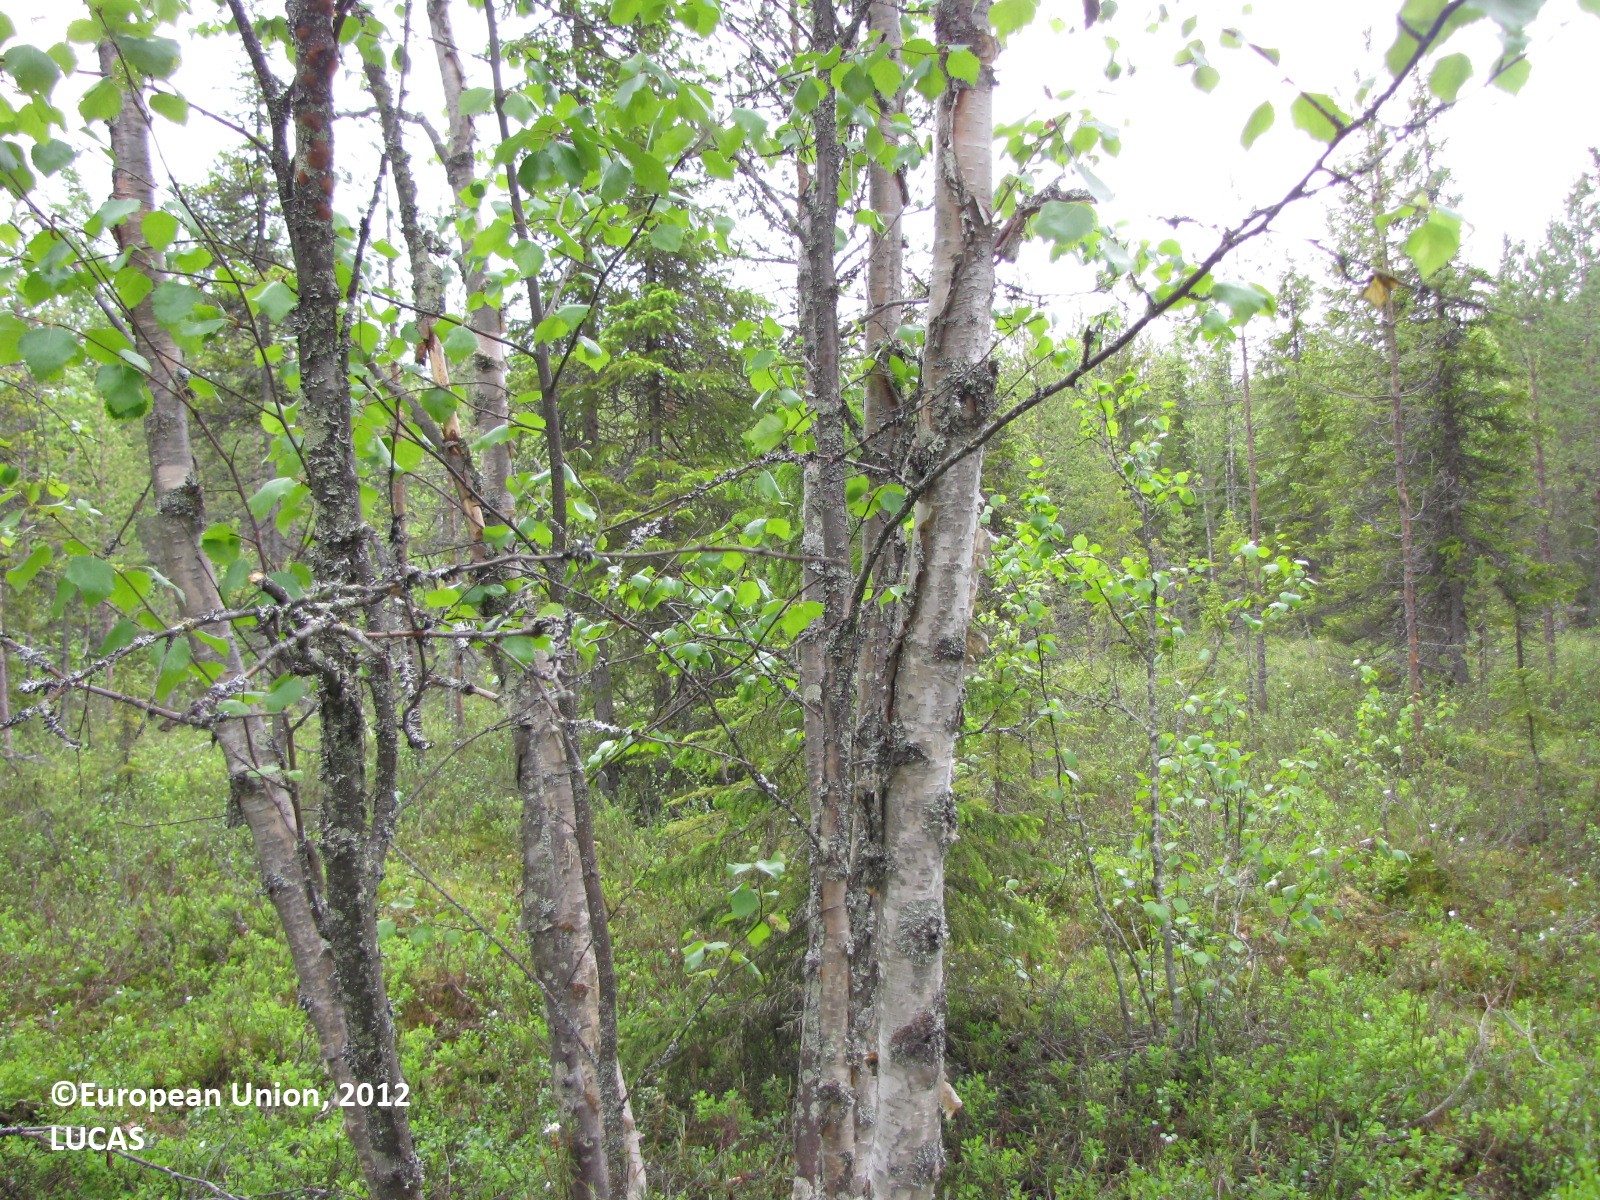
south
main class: Woodland
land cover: Other mixed woodland
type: boreal forest
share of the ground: 50 - 75 %
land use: Forestry
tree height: > 5 m
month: June
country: FI
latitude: 66.1278
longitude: 24.6902
